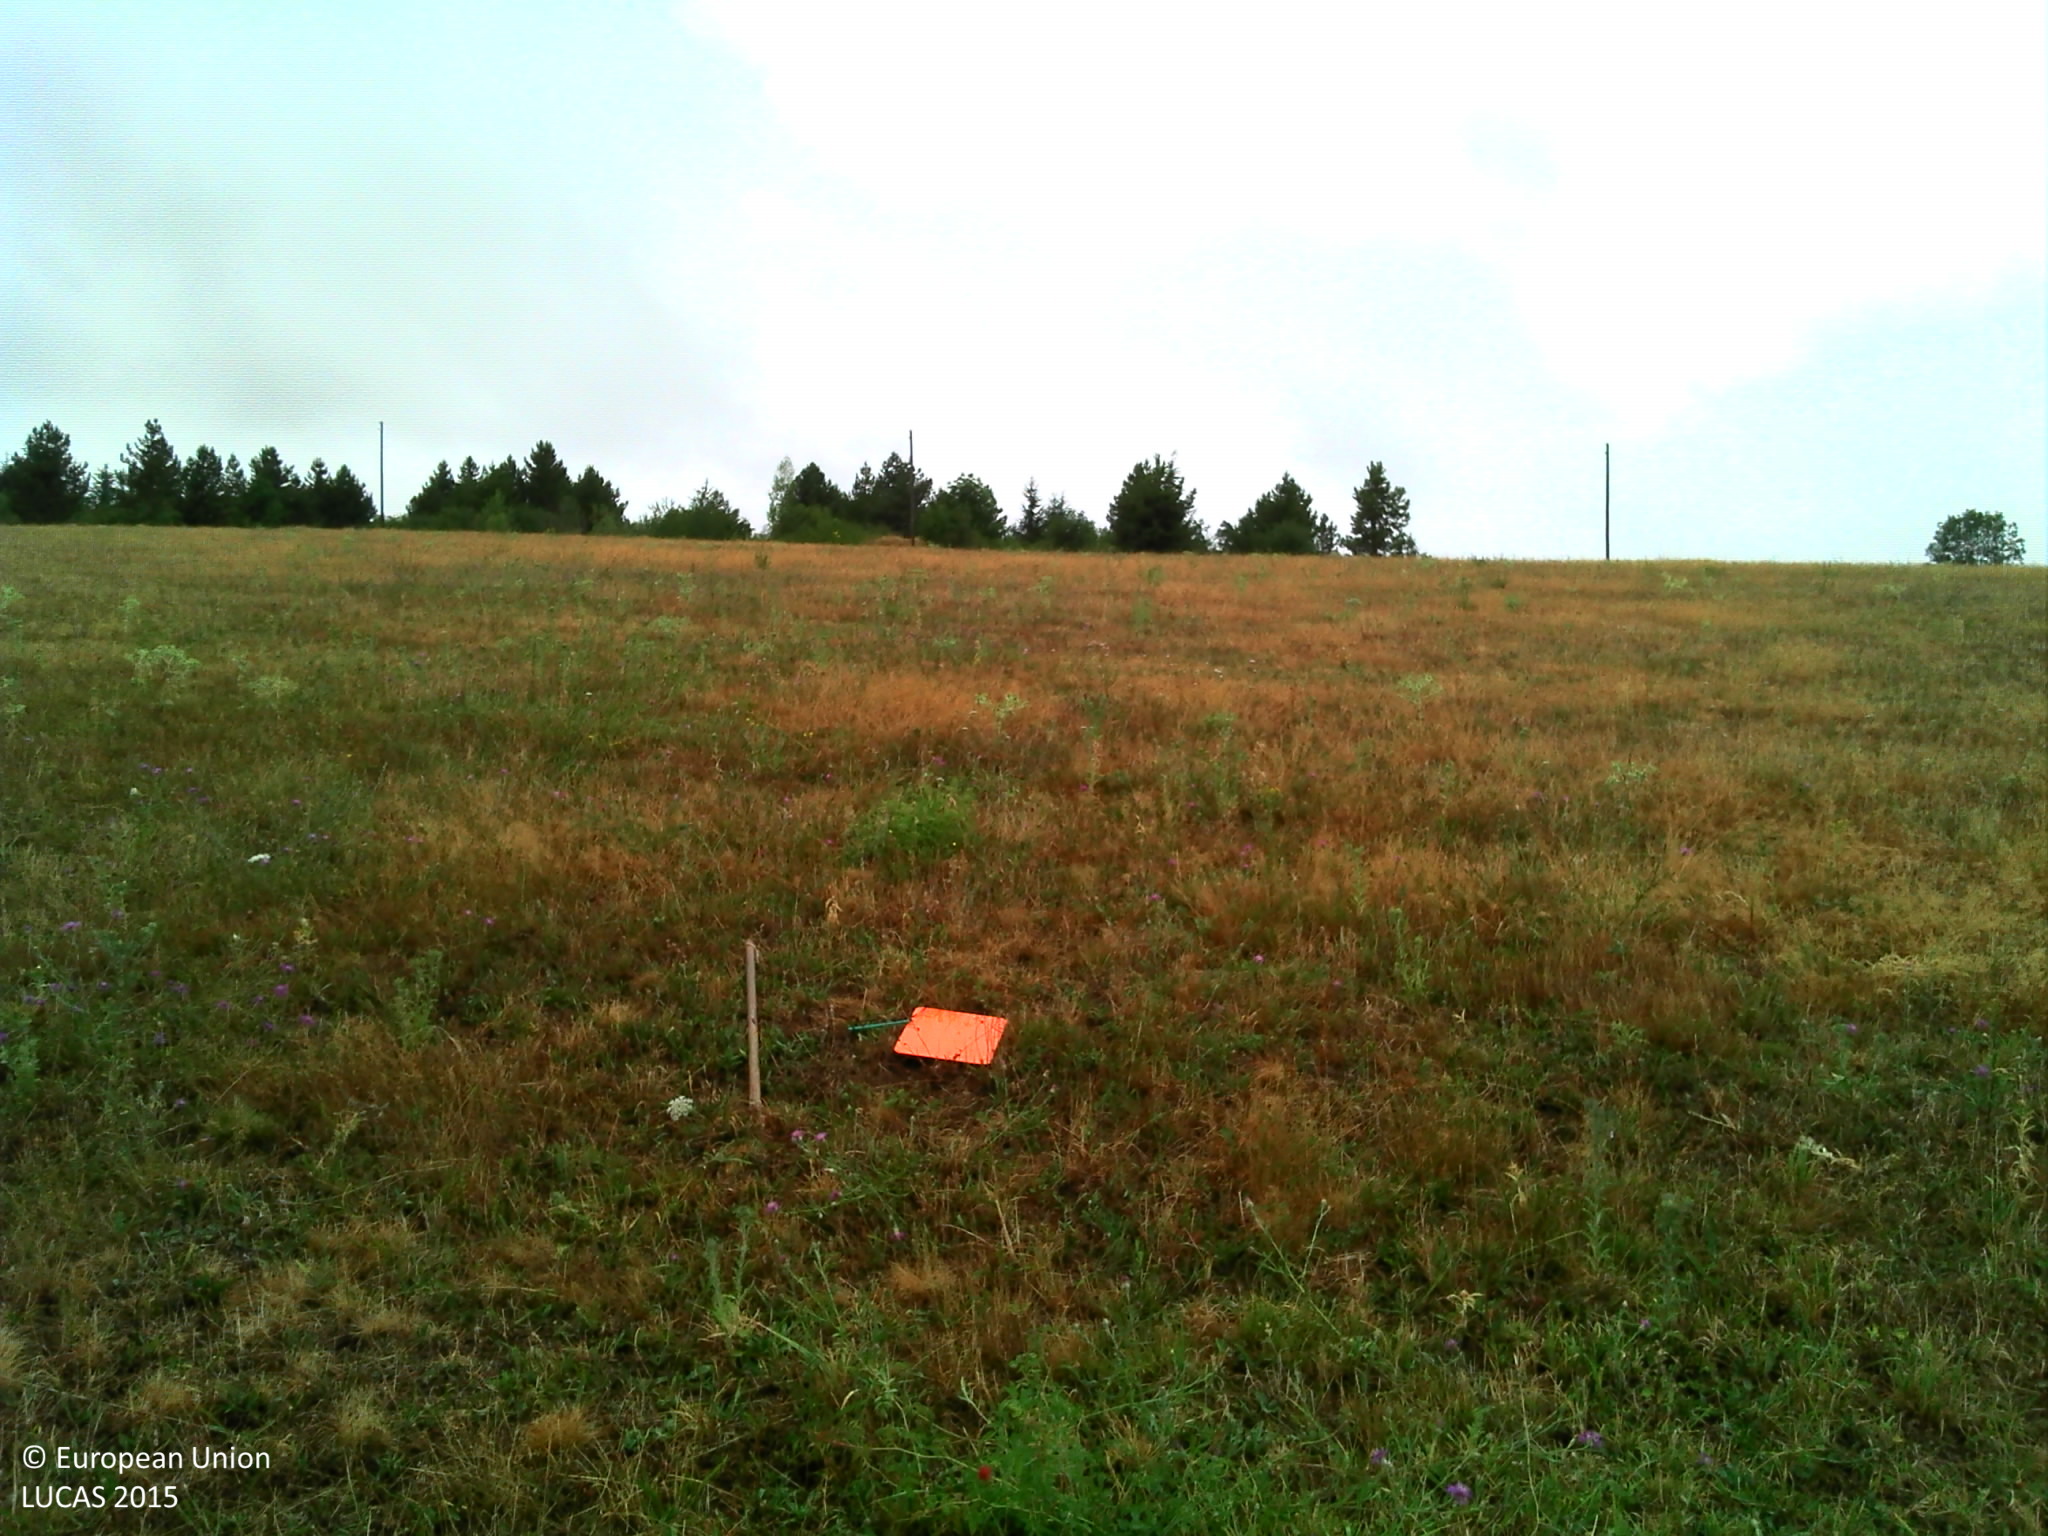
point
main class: Grassland
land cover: Grassland without tree/shrub cover
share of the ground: > 75 %
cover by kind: herbaceous plants 90 %, unconsolidated bare surface 10 %
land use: Agriculture (excluding fallow land and kitchen gardens)
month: August
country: FR
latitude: 45.4856
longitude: 4.1306
